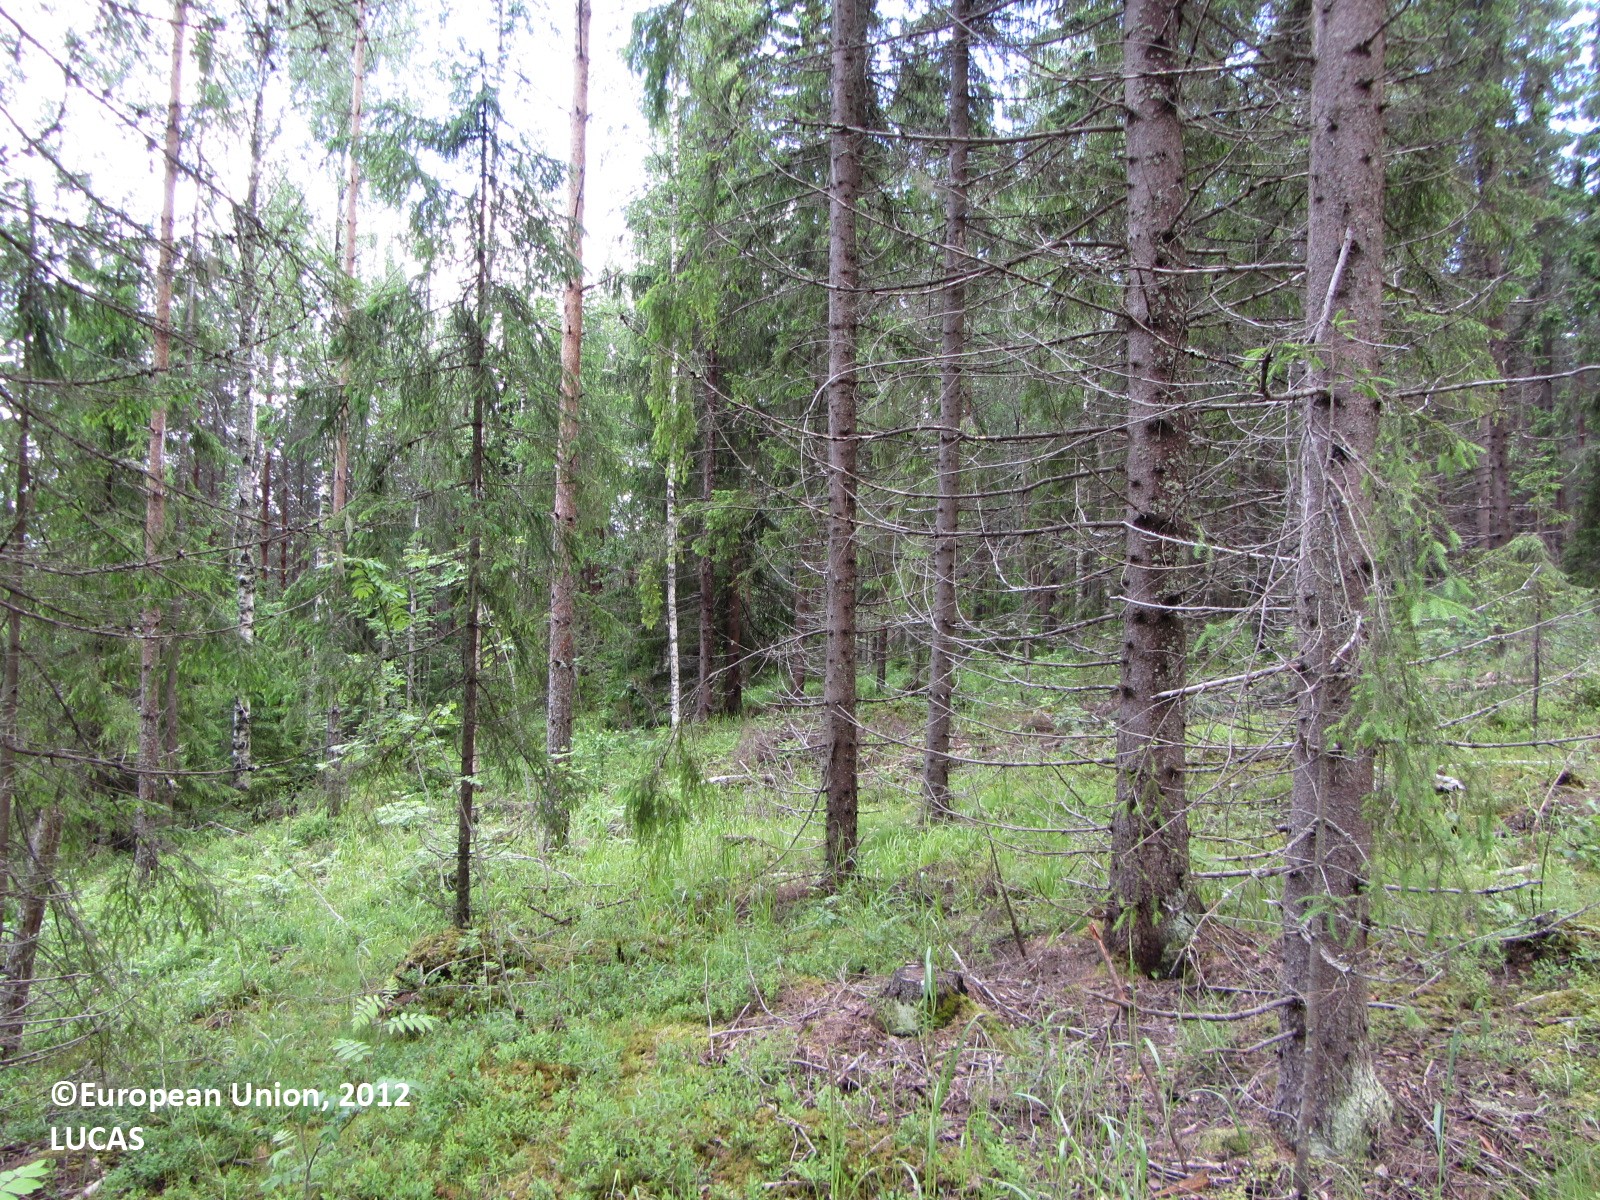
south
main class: Woodland
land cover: Other coniferous woodland
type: boreal forest
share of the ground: 50 - 75 %
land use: Forestry
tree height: > 5 m
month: June
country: FI
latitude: 61.9207
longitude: 25.2517
